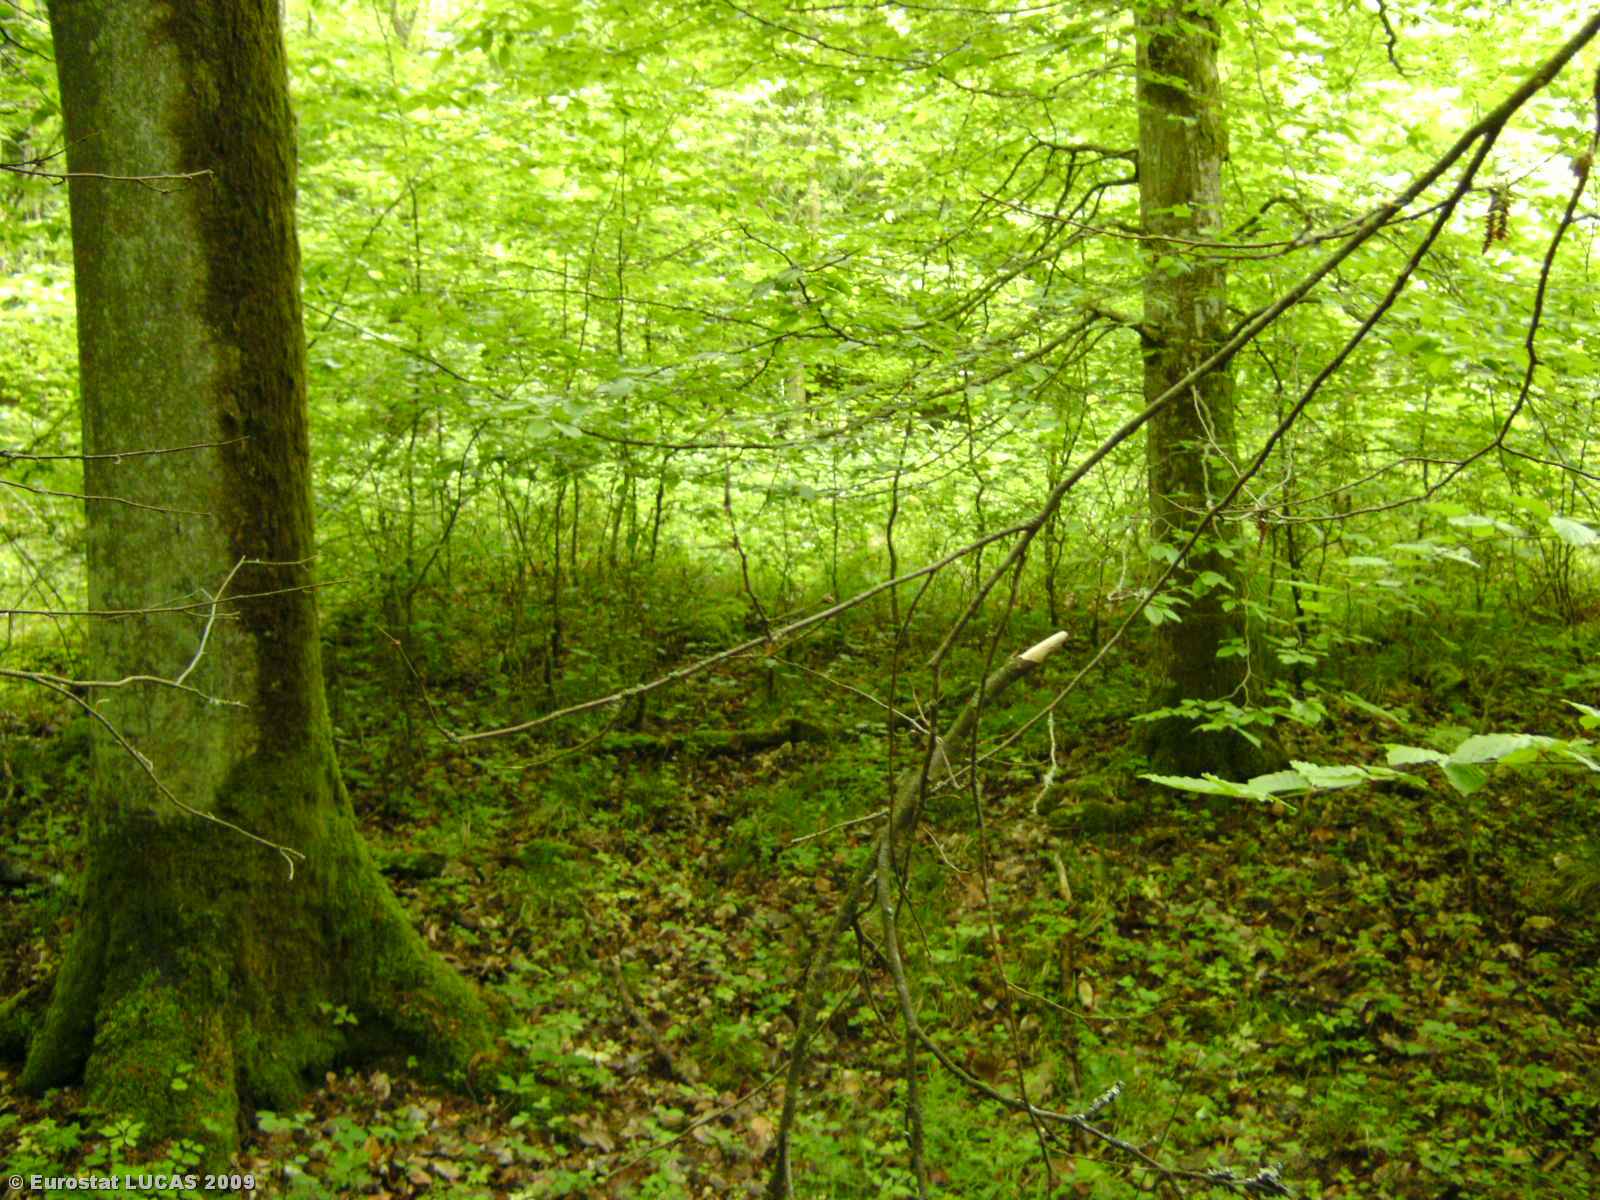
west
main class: Woodland
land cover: Broadleaved woodland
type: beech forest
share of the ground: > 75 %
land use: Forestry
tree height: > 5 m
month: May
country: LU
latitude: 49.6912
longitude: 6.2706
